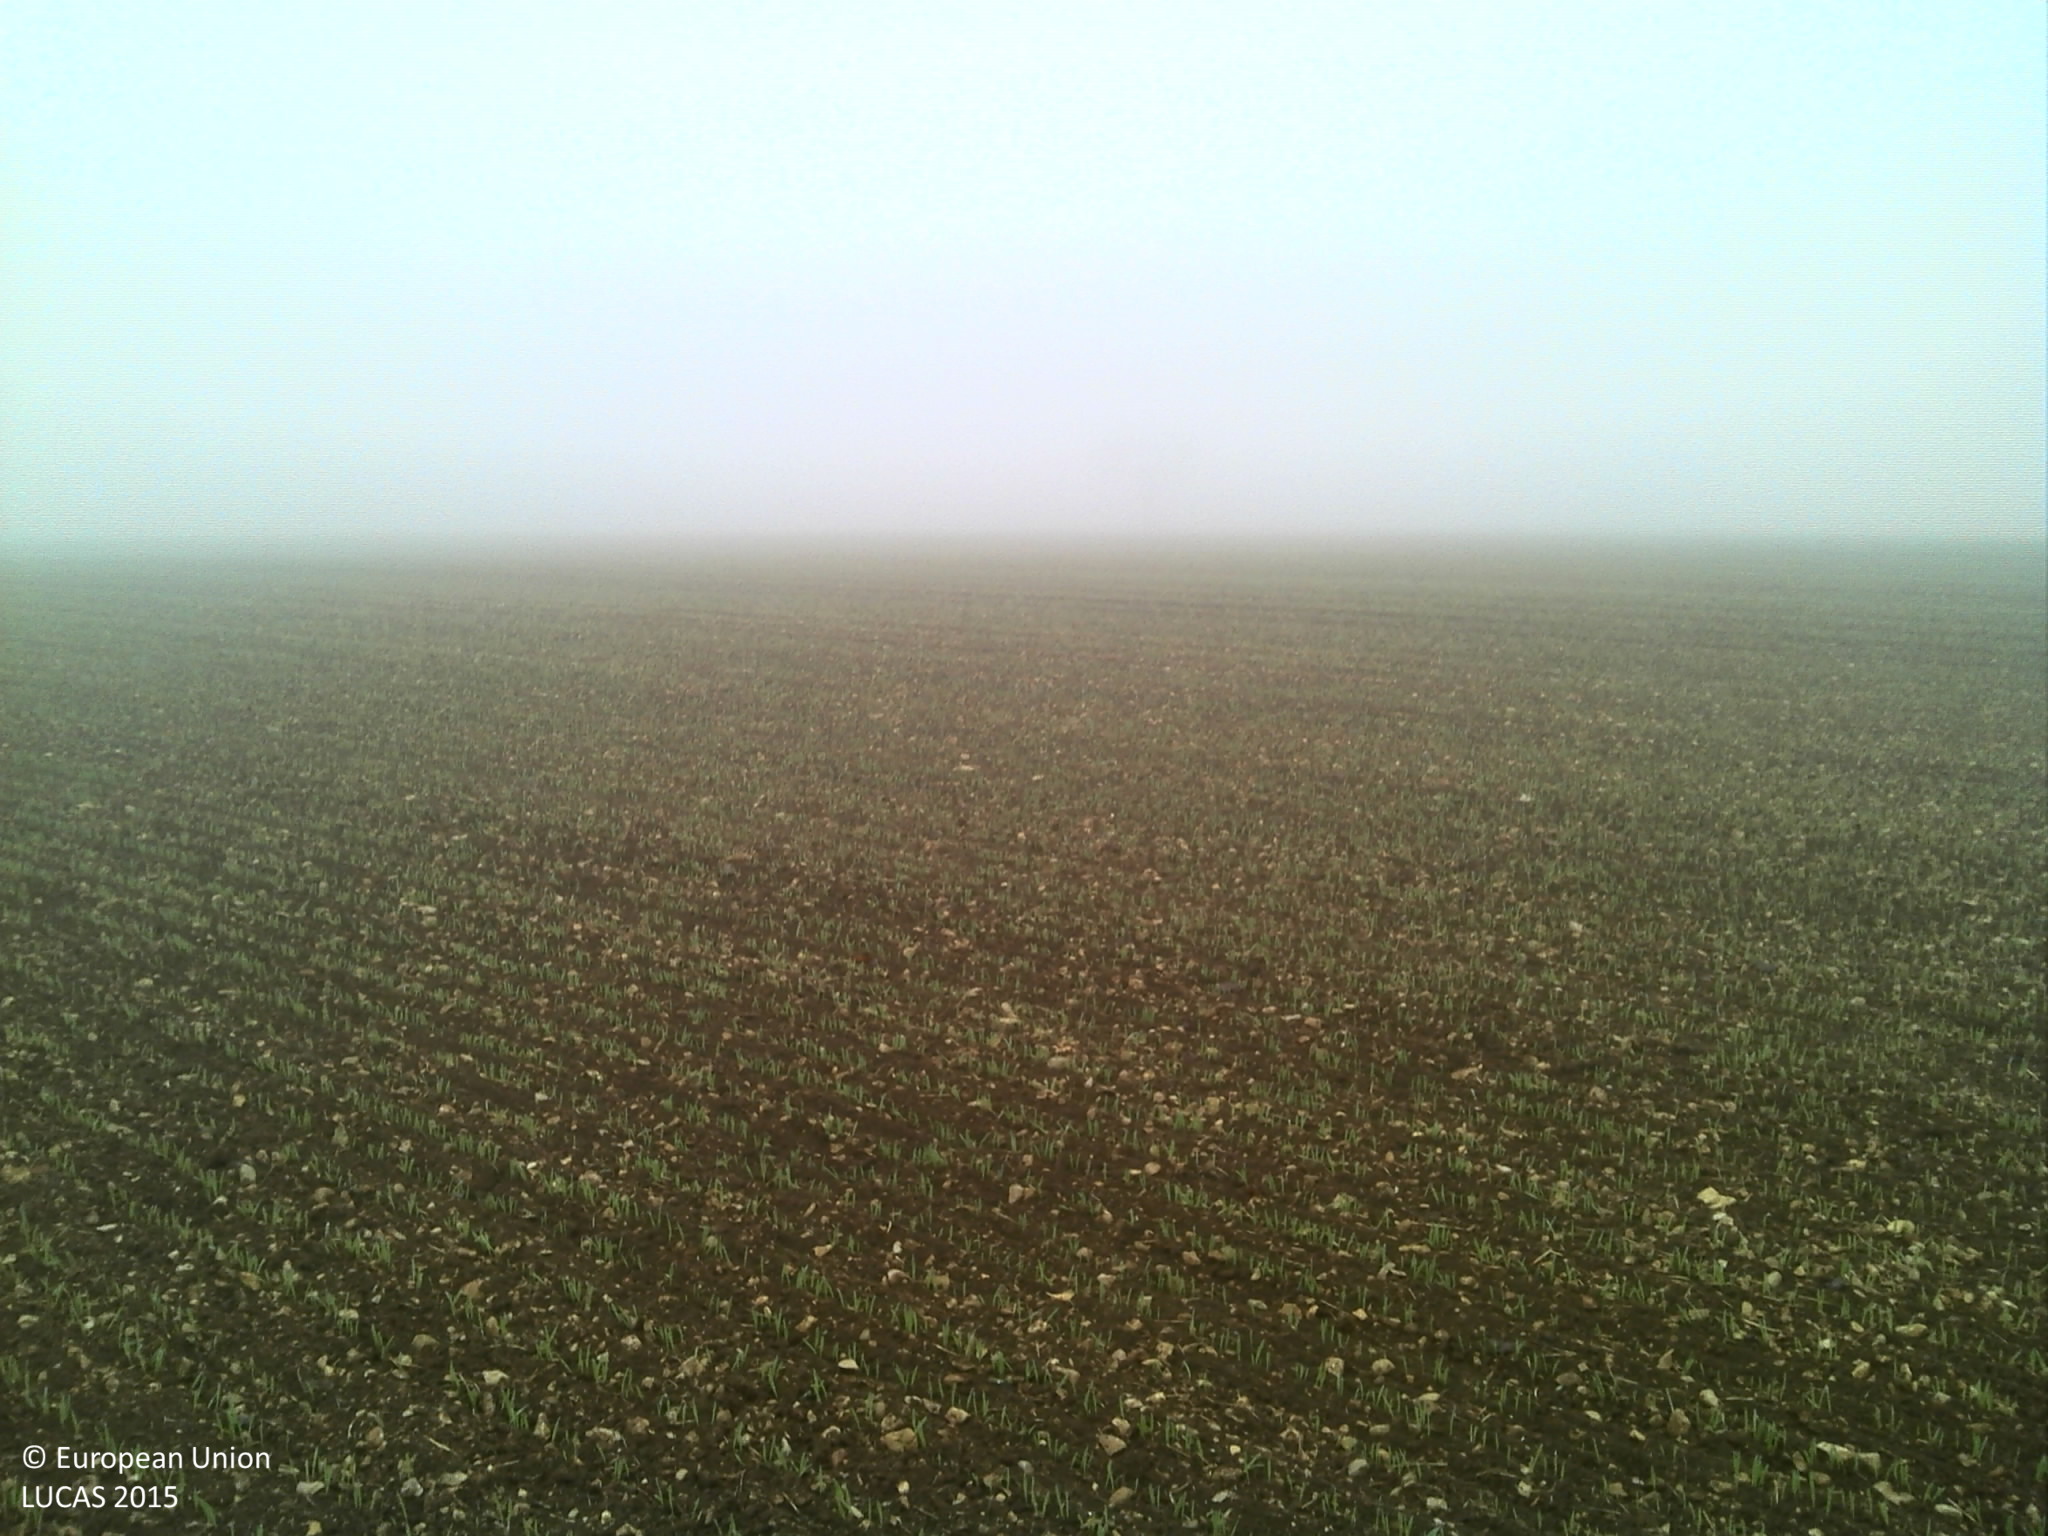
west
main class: Cropland
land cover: Common wheat
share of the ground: 10 - 25 %
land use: Agriculture (excluding fallow land and kitchen gardens)
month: October
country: FR
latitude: 47.4299
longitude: 5.1083
